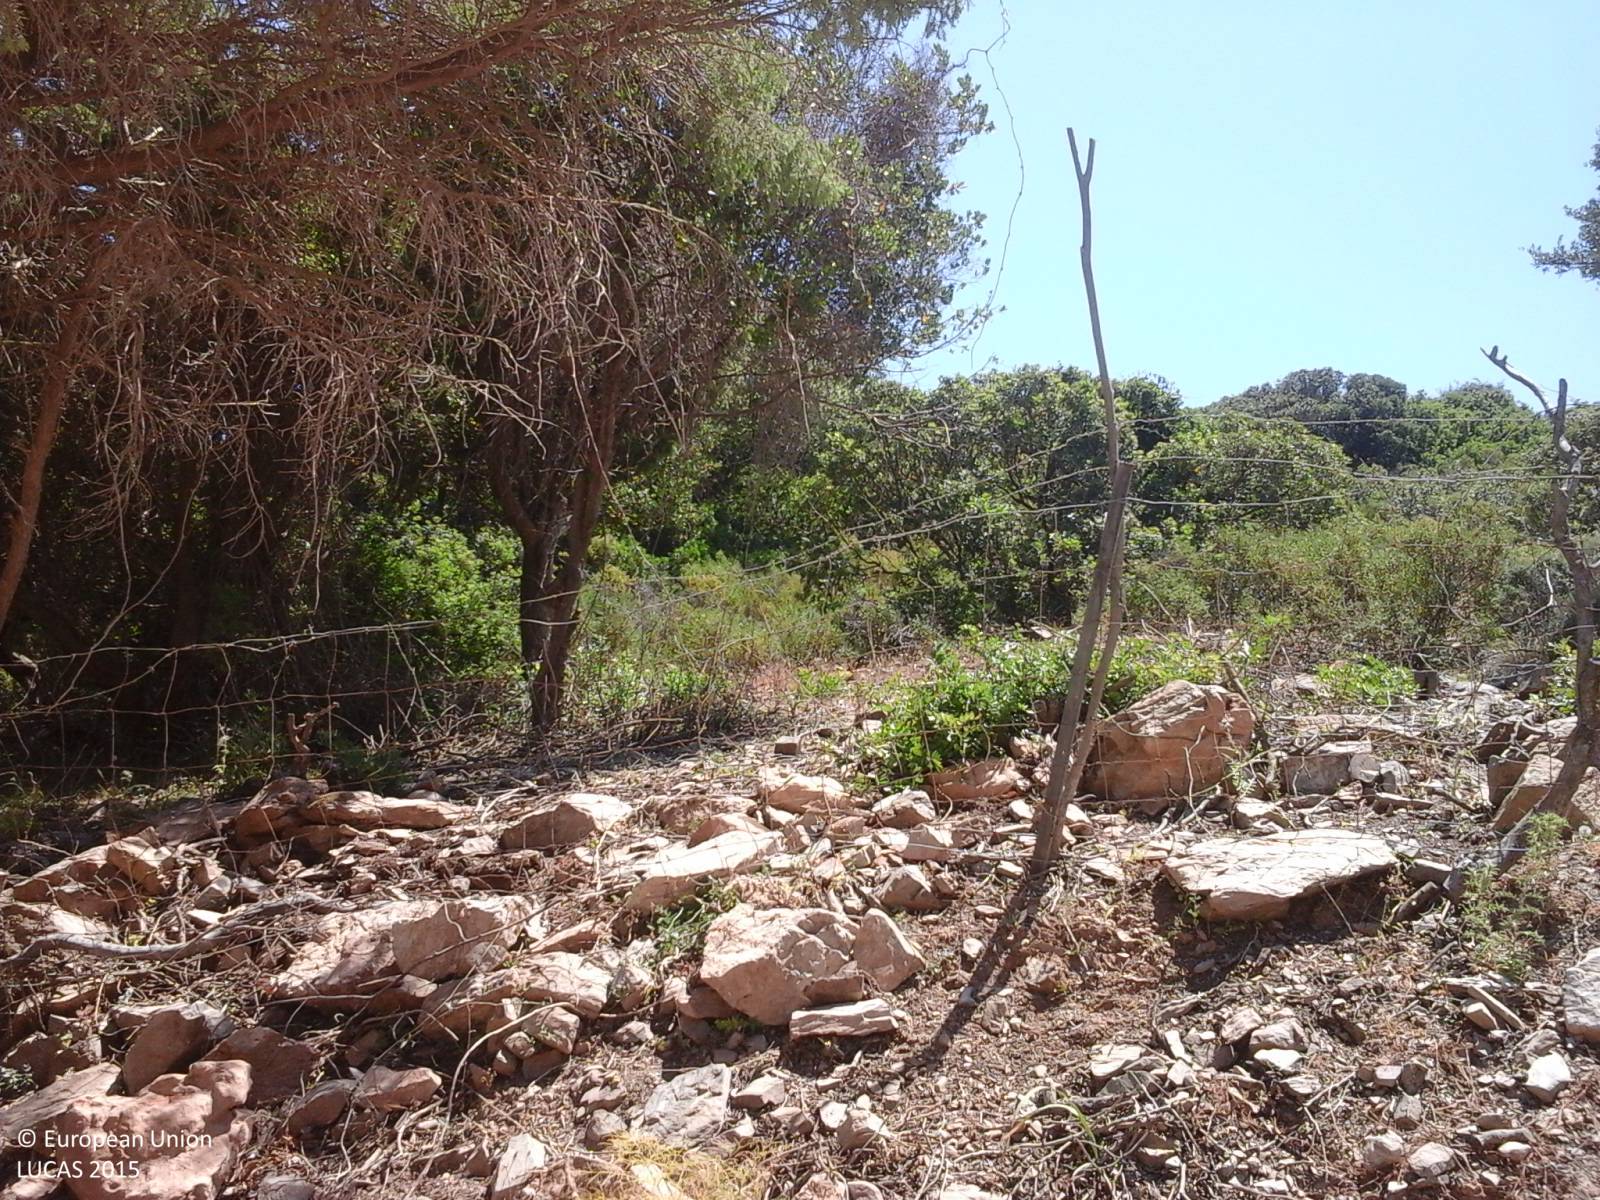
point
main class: Woodland
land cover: Broadleaved woodland
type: broadleaved evergreen forest
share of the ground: > 75 %
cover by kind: broadleaved forest trees 50 %, shrubs 30 %, coniferous forest trees 10 %, herbaceous plants 10 %
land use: Agriculture (excluding fallow land and kitchen gardens)
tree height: > 5 m
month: June
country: IT
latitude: 38.9552
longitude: 8.7732
